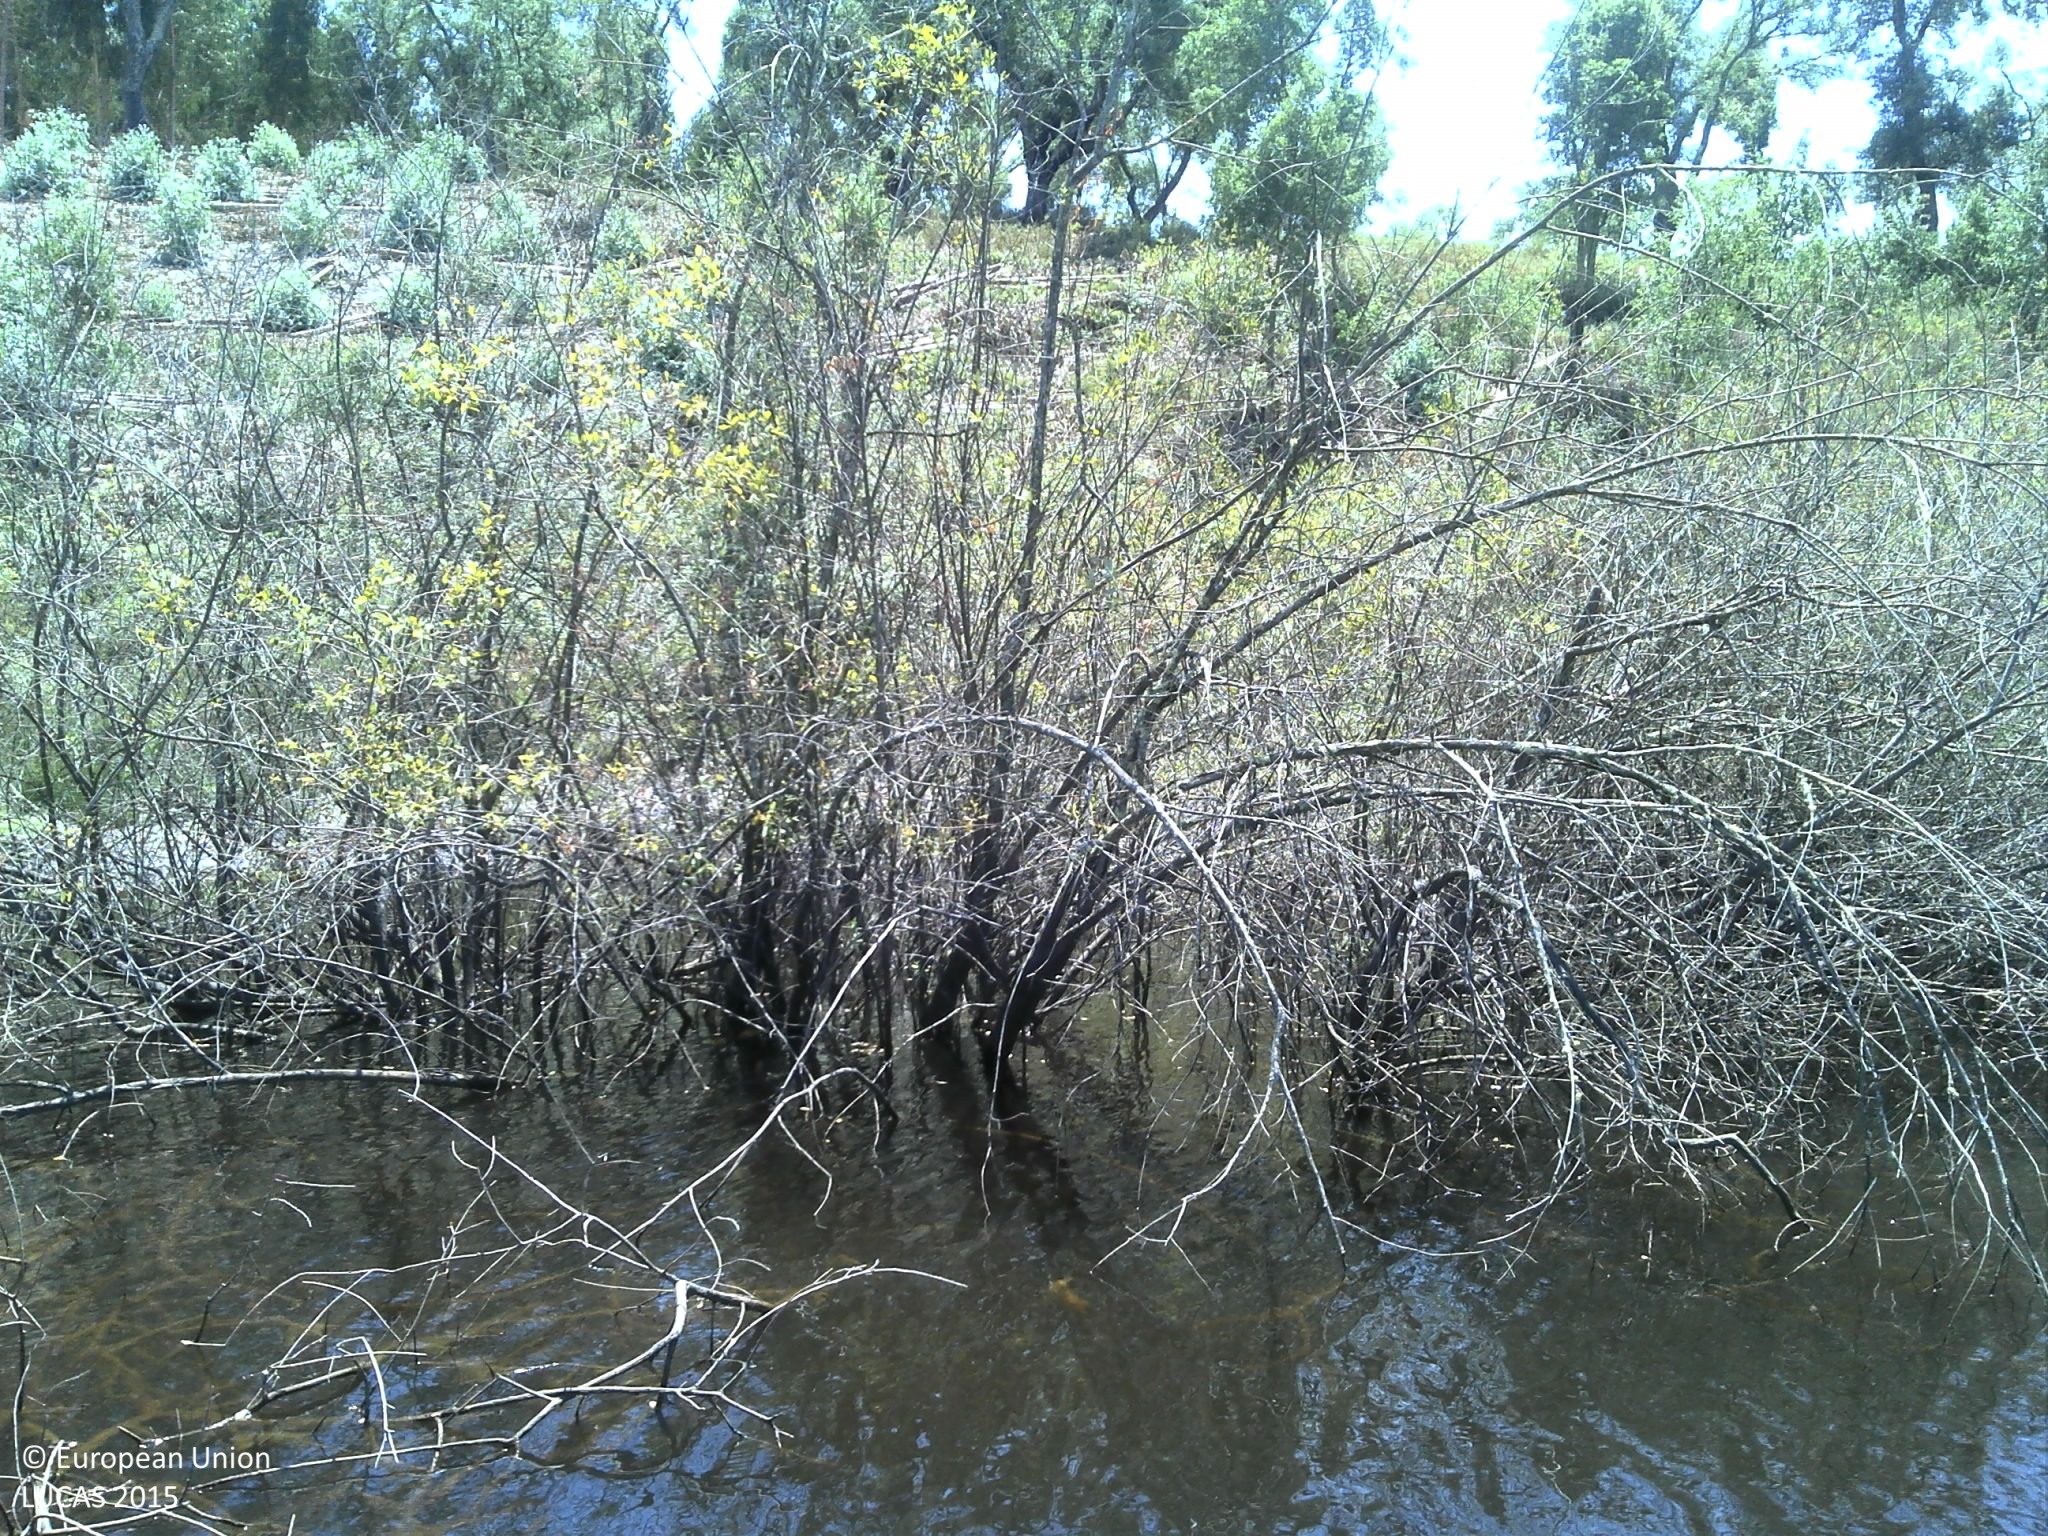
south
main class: Shrubland
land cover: Shrubland without tree cover
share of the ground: 25 - 50 %
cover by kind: unconsolidated bare surface 50 %, shrubs 40 %, herbaceous plants 10 %
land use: Semi-natural and natural areas not in use
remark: Temporary dry
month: July
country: PT
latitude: 39.2527
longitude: -8.2901
